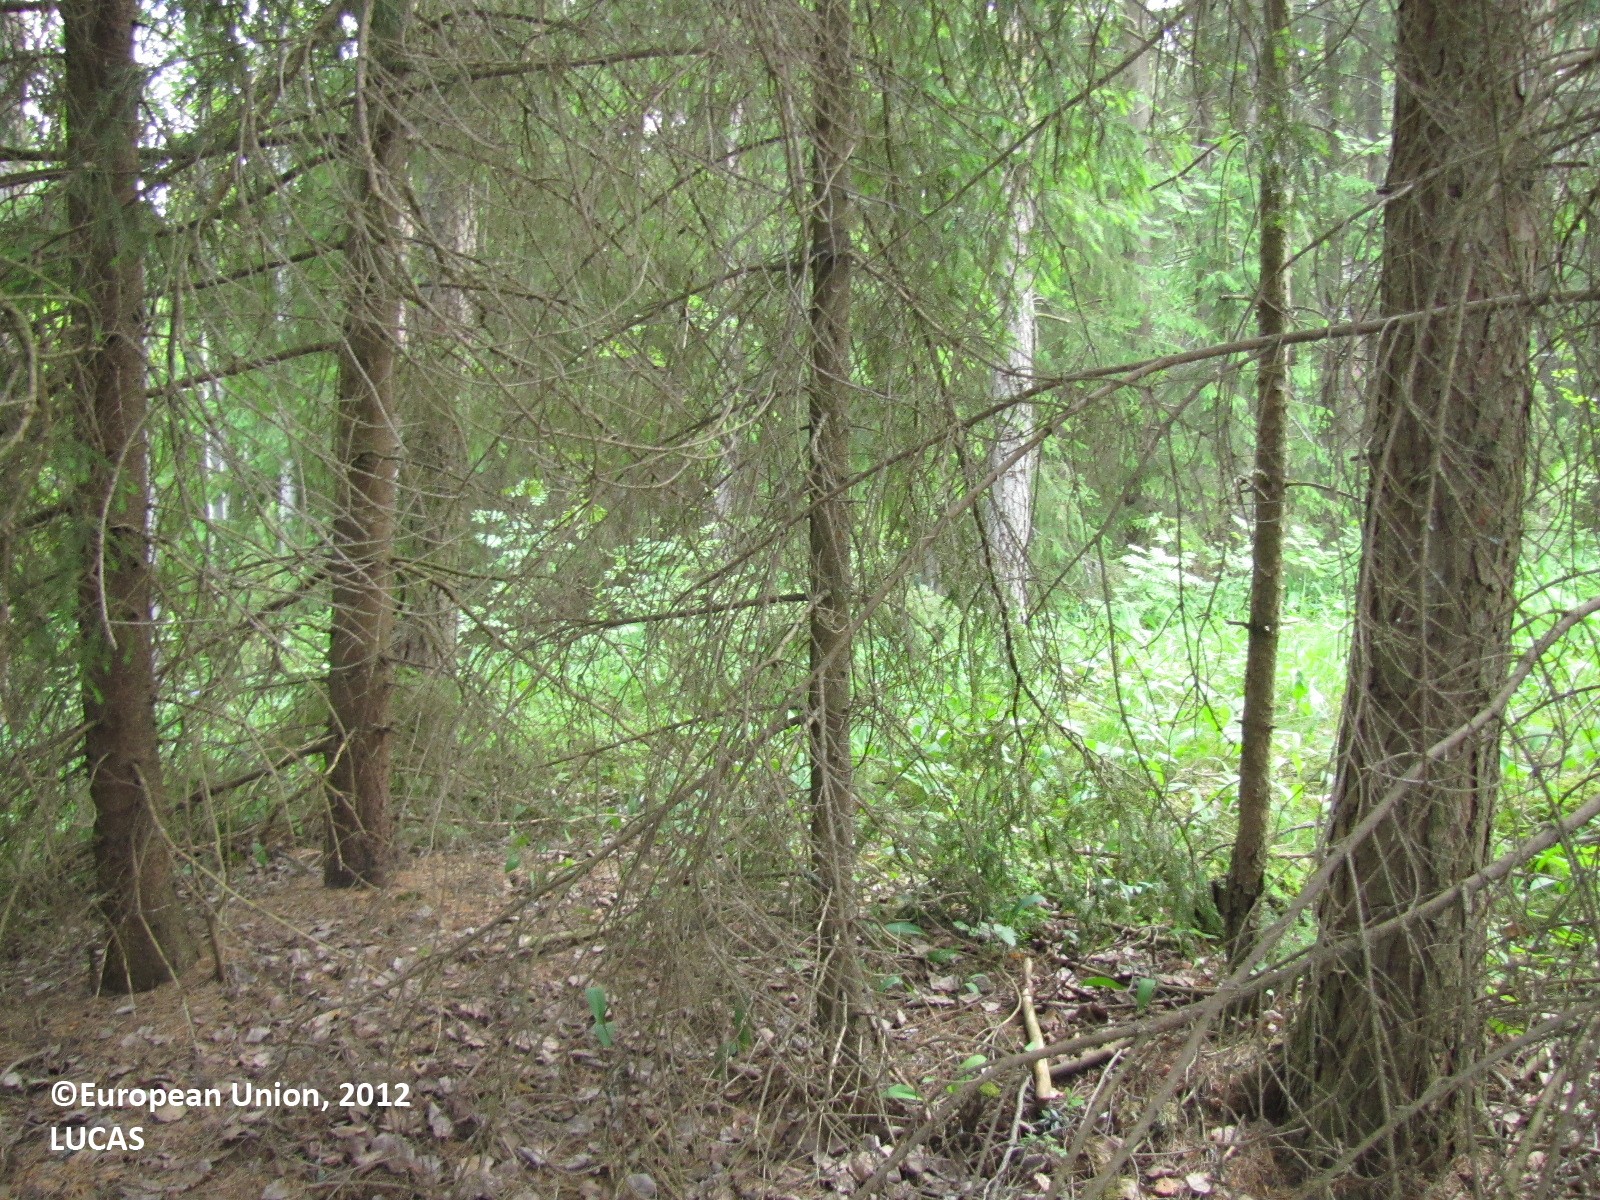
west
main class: Woodland
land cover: Spruce dominated coniferous woodland
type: boreal forest
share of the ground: 25 - 50 %
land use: Forestry
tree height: > 5 m
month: June
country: FI
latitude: 61.4897
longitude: 24.4266
